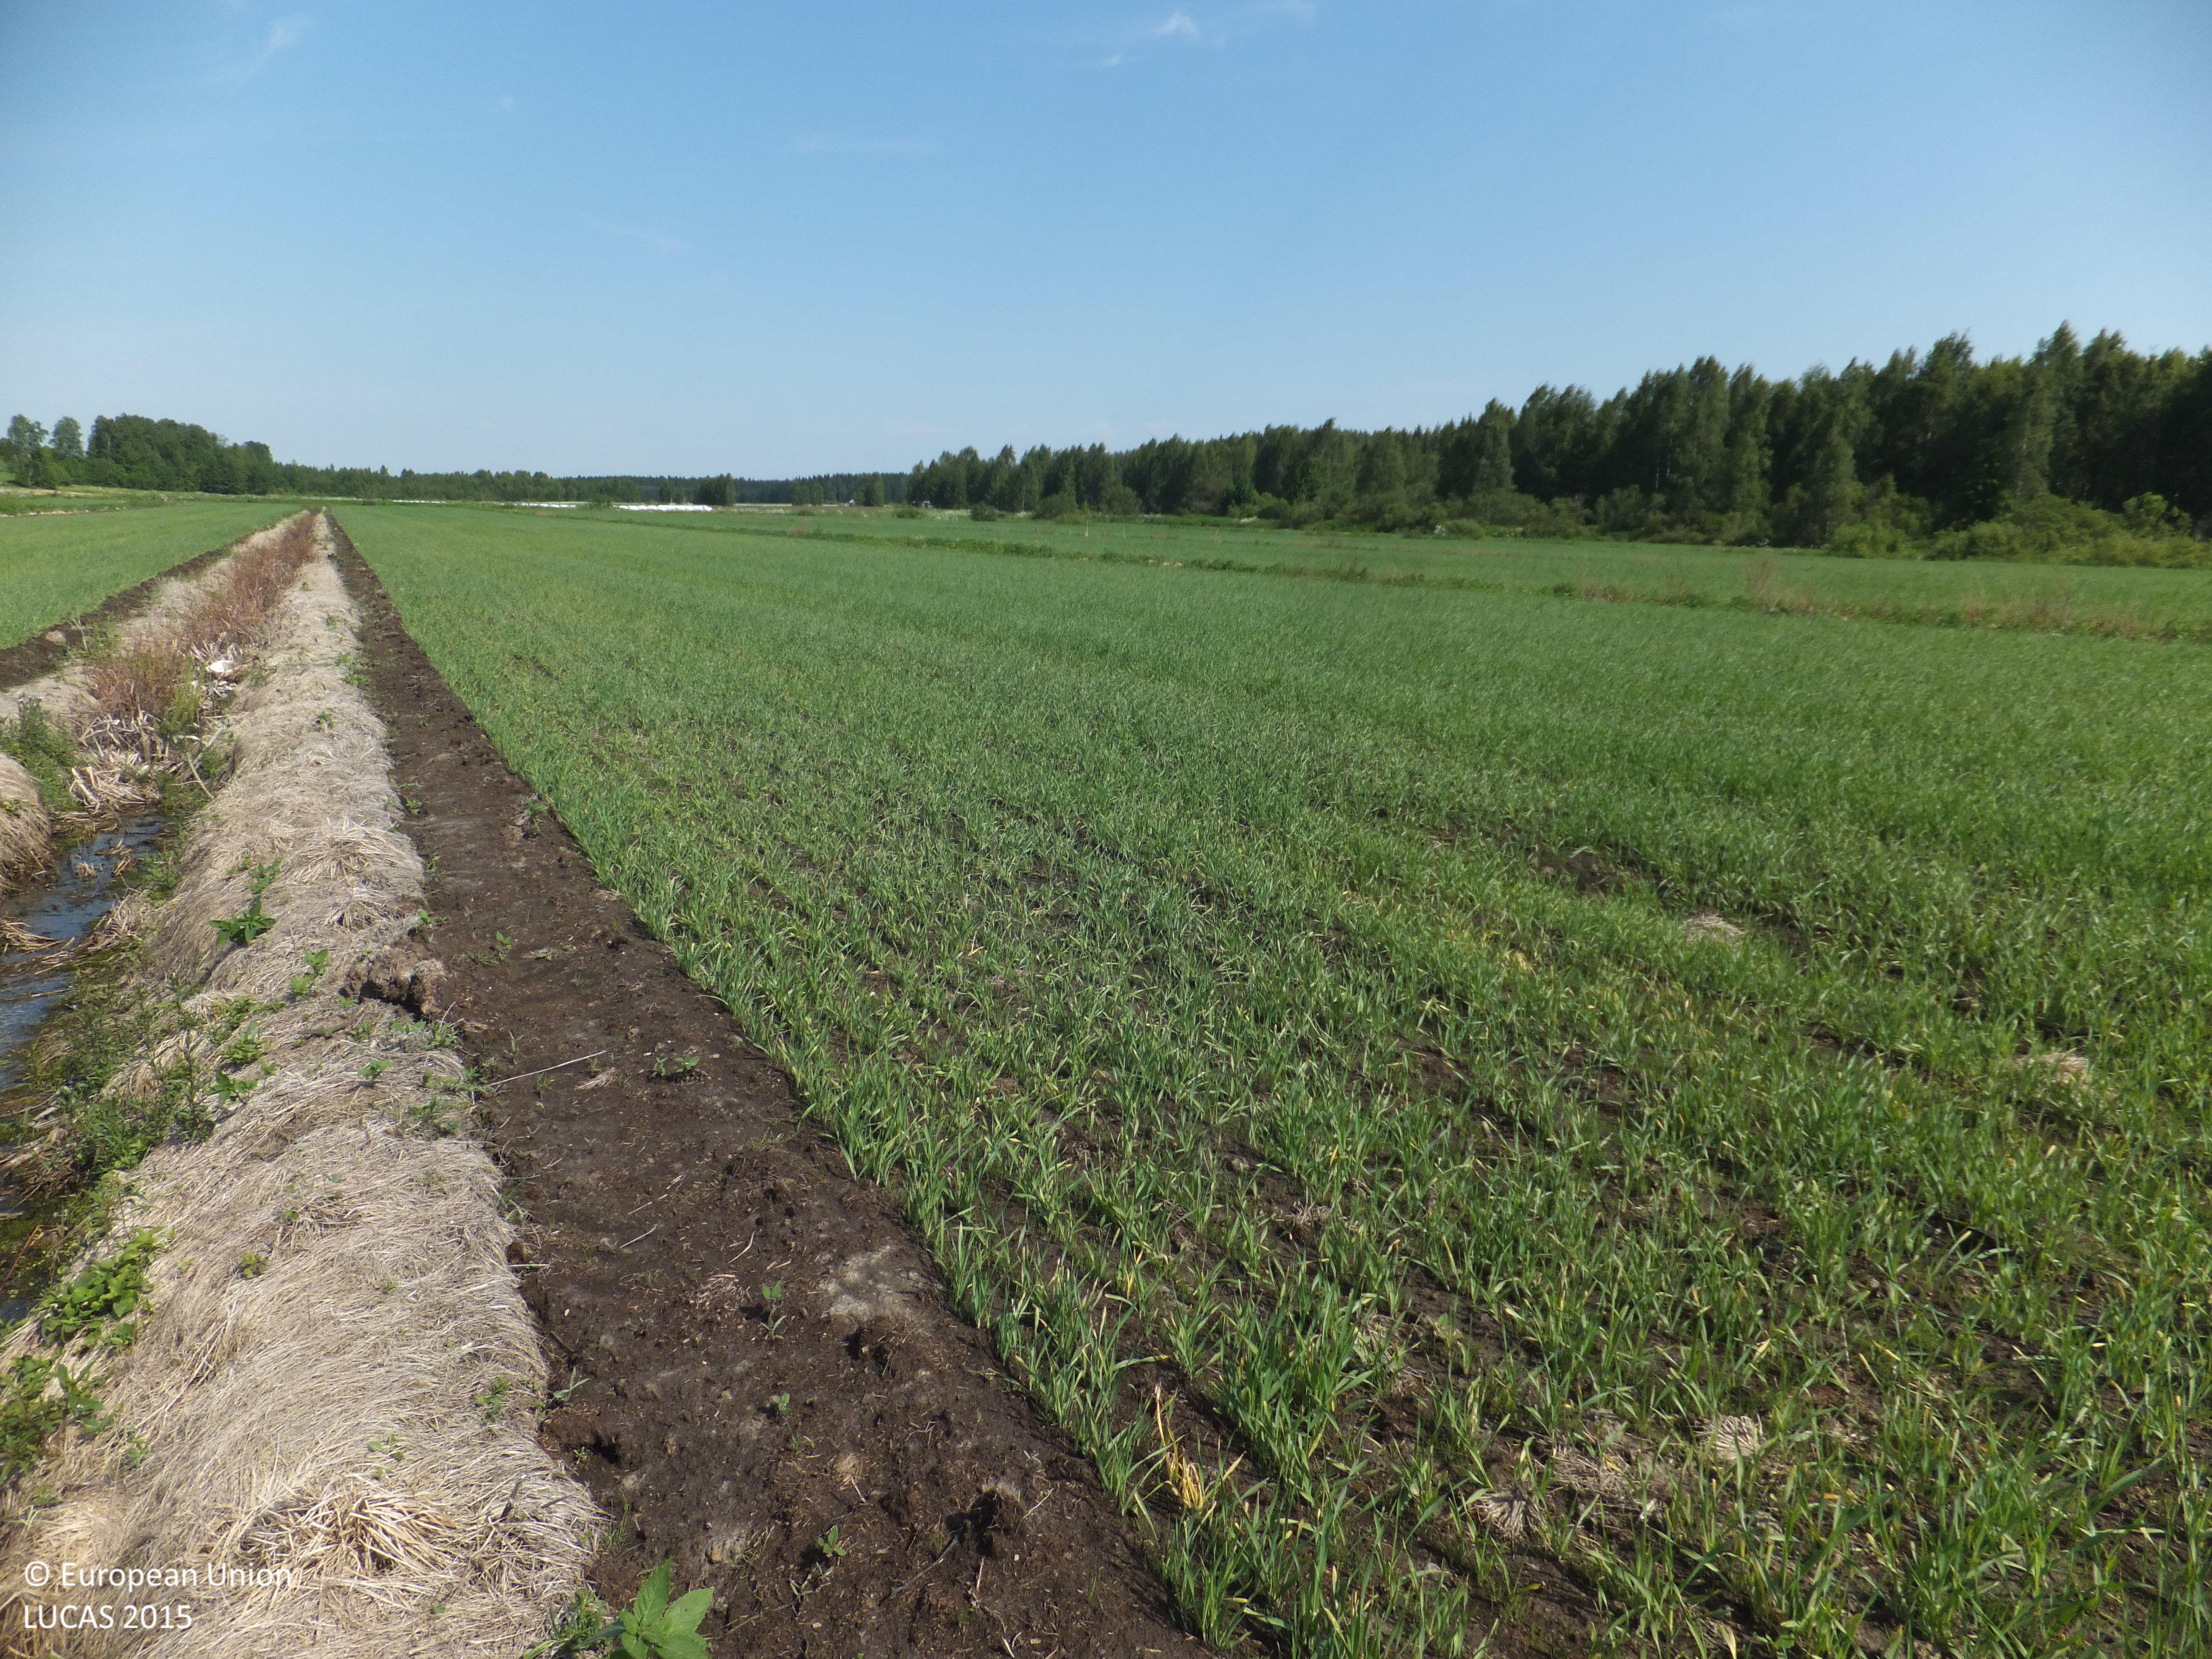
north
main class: Cropland
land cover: Barley
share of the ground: 25 - 50 %
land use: Agriculture (excluding fallow land and kitchen gardens)
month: July
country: FI
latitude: 63.2625
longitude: 23.7554
